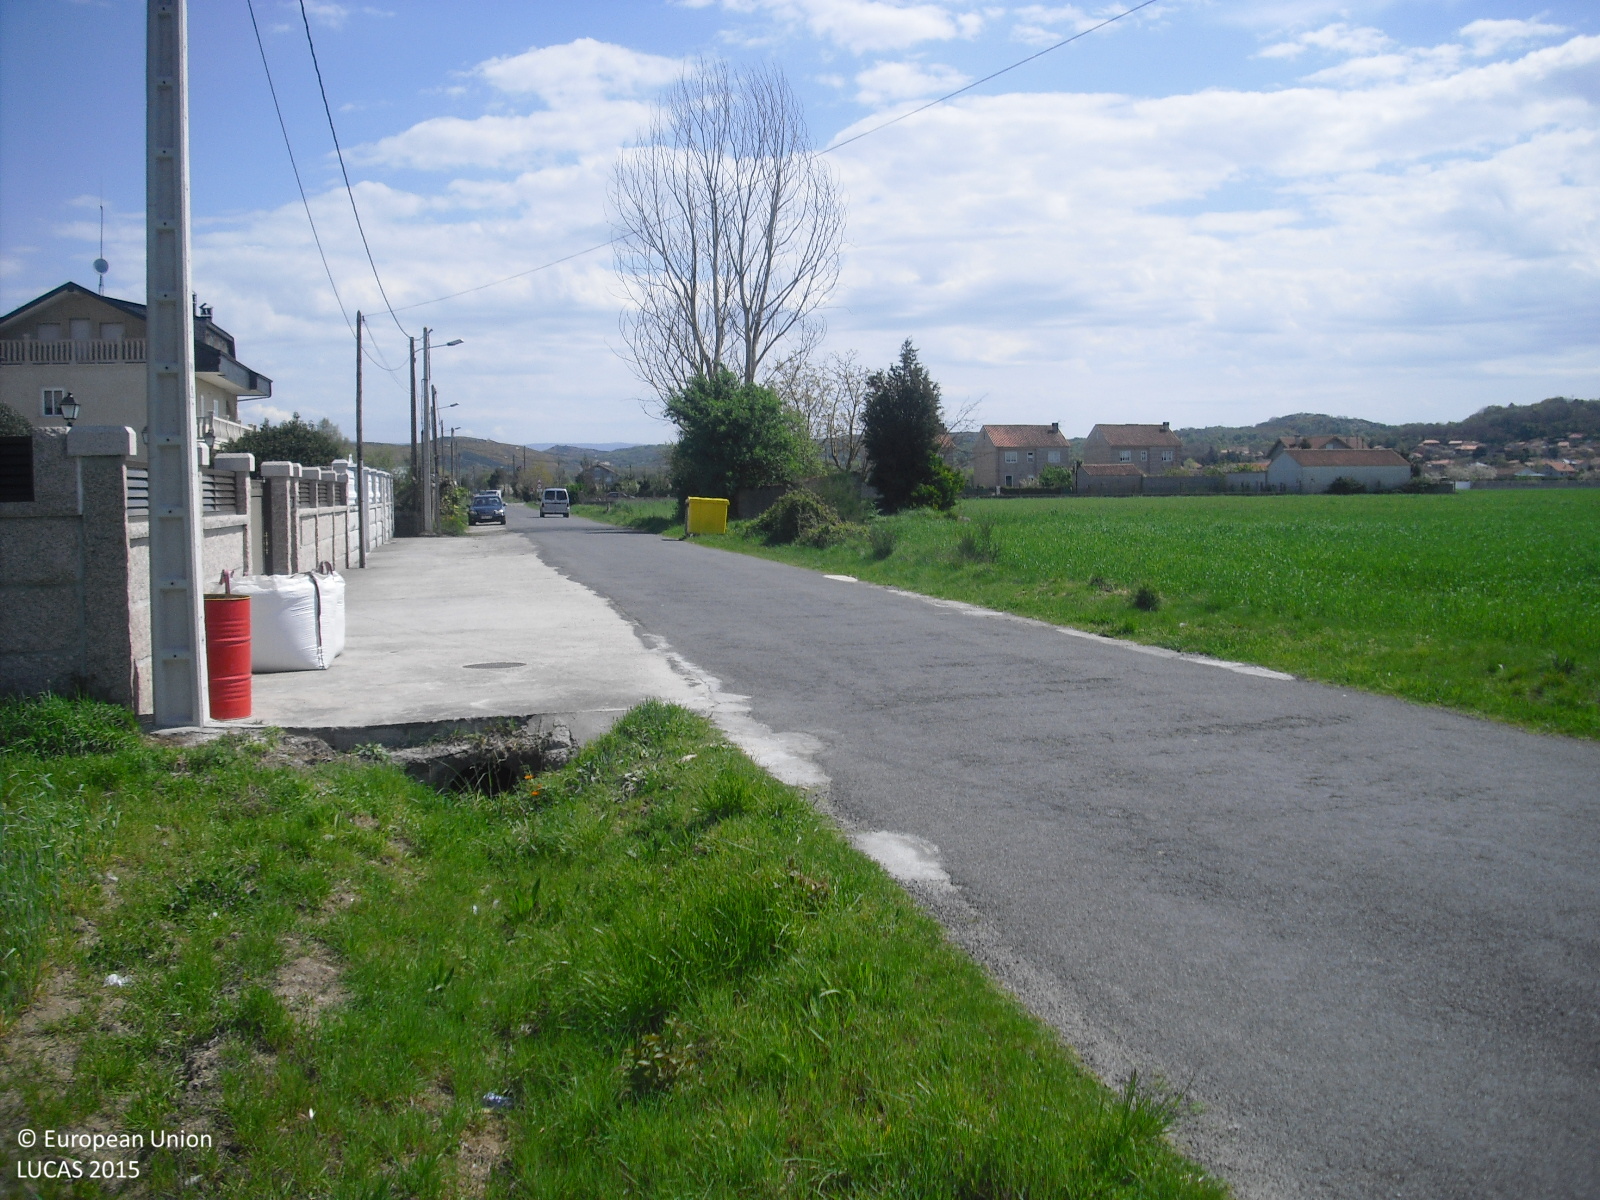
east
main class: Cropland
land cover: Rye
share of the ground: > 75 %
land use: Agriculture (excluding fallow land and kitchen gardens)
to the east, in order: Grass margins; Paved roads, cycling and walking lanes; Electric lines; Paved roads, cycling and walking lanes; Electric lines; Paved roads, cycling and walking lanes; Rye; Grass margins; Ditches and canals; Shruby margins; Common wheat; Grass margins; Fences; Grassland with sparse tree/shrub cover; Artificial constructions in urban areas
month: April
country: ES
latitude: 42.0715
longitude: -7.7277
